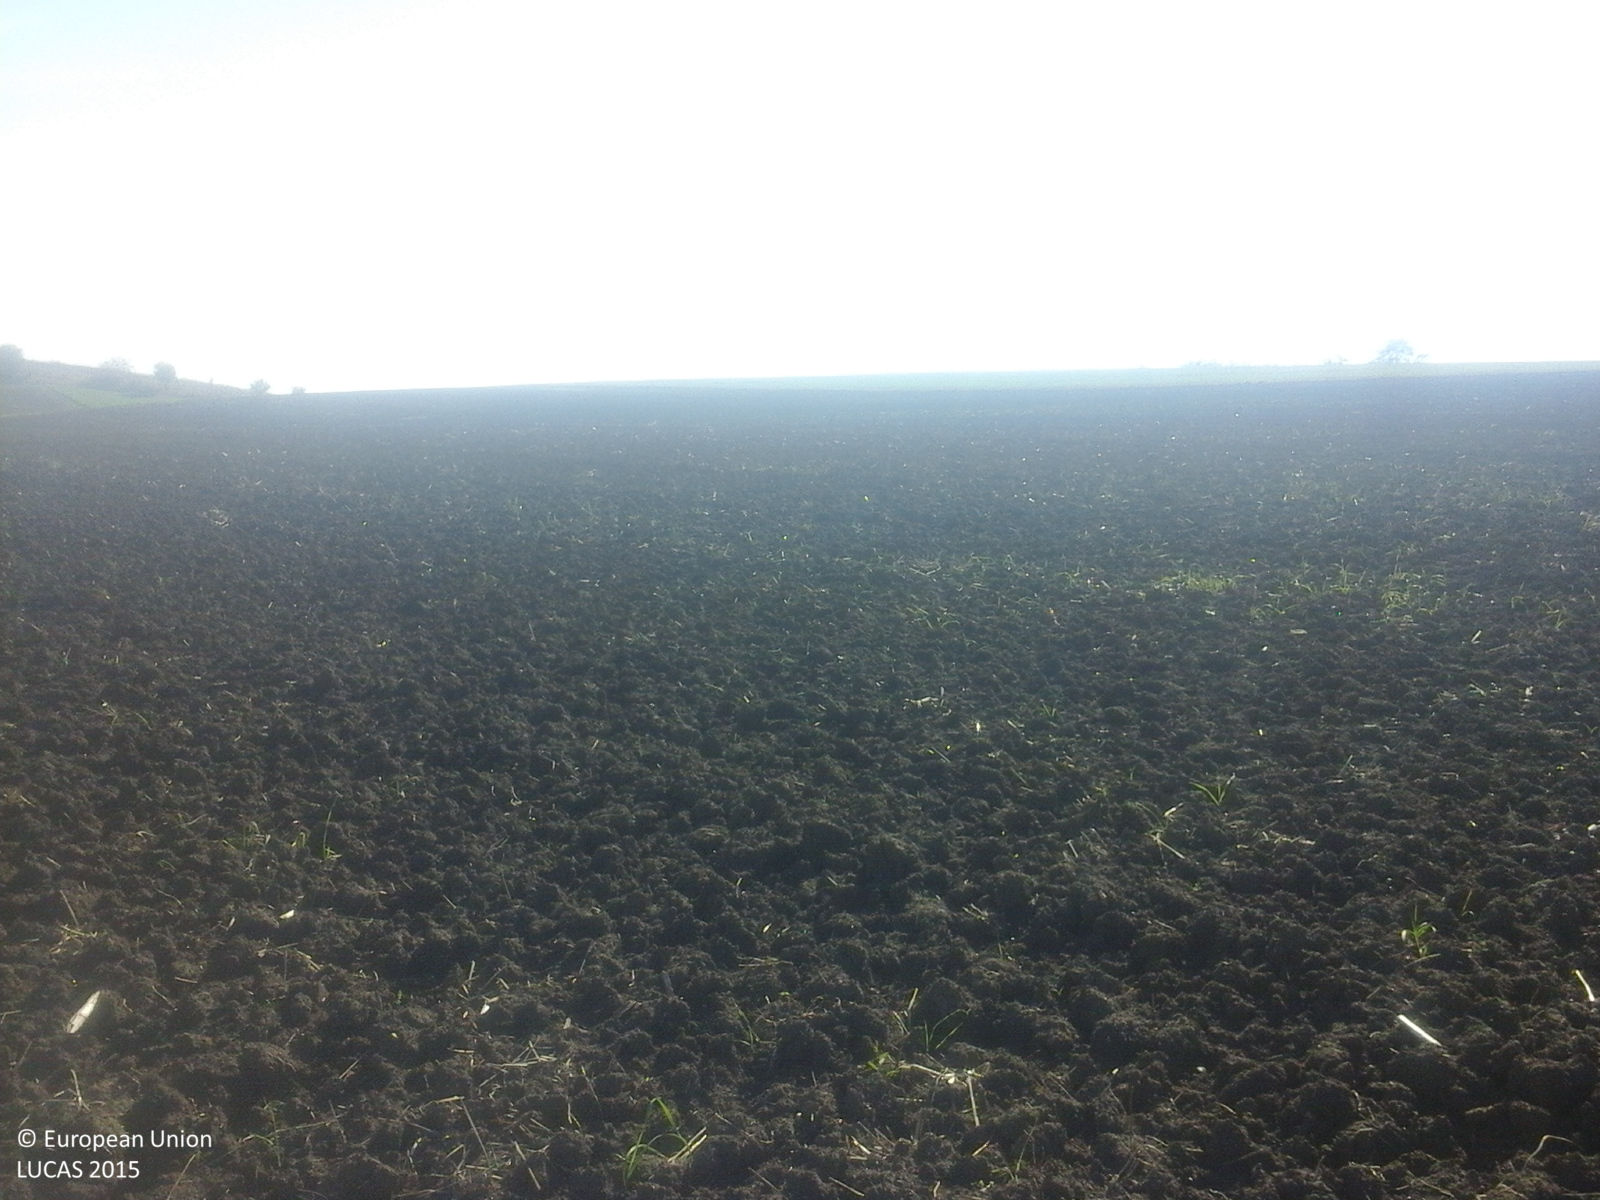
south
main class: Cropland
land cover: Barley
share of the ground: < 10 %
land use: Agriculture (excluding fallow land and kitchen gardens)
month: October
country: RO
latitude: 45.9378
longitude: 23.9898
